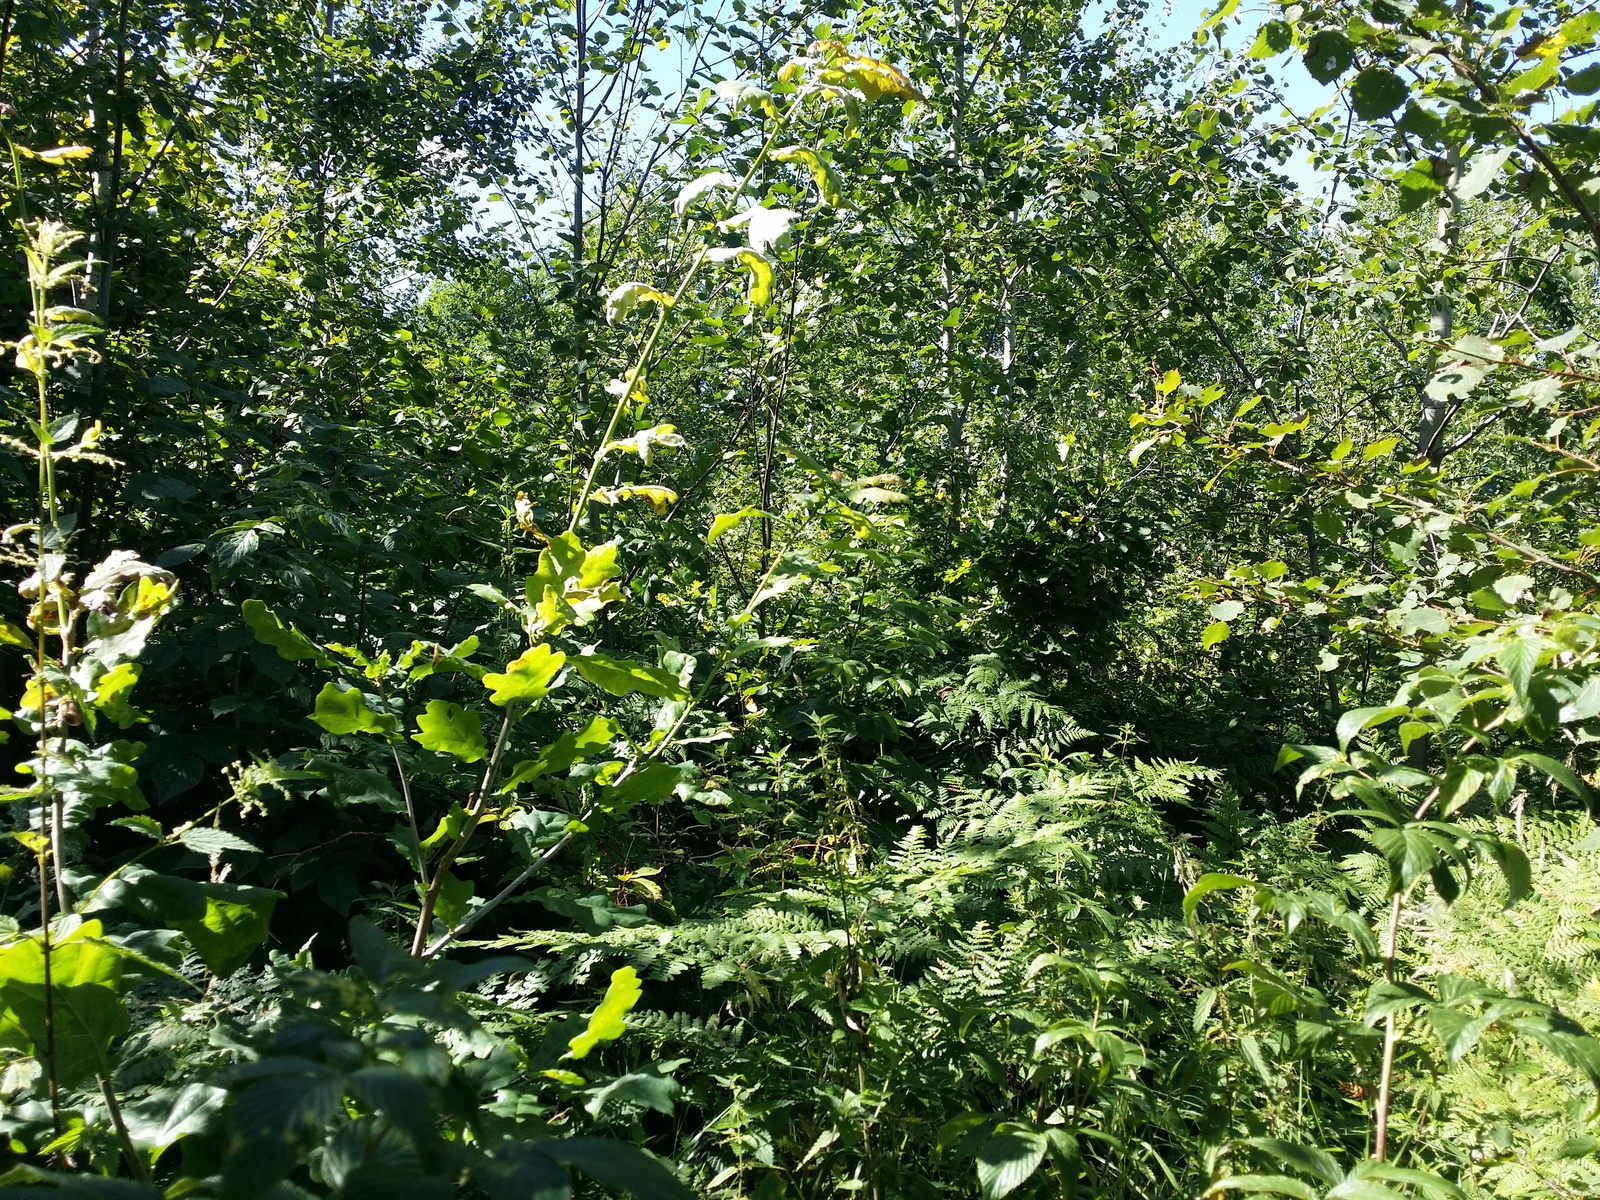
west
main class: Woodland
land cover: Broadleaved woodland
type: non-riverine alder, birch or aspen forest
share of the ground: > 75 %
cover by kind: broadleaved forest trees 90 %, herbaceous plants 10 %
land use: Forestry
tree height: < 5 m
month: August
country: LV
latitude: 57.0515
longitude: 27.6734
